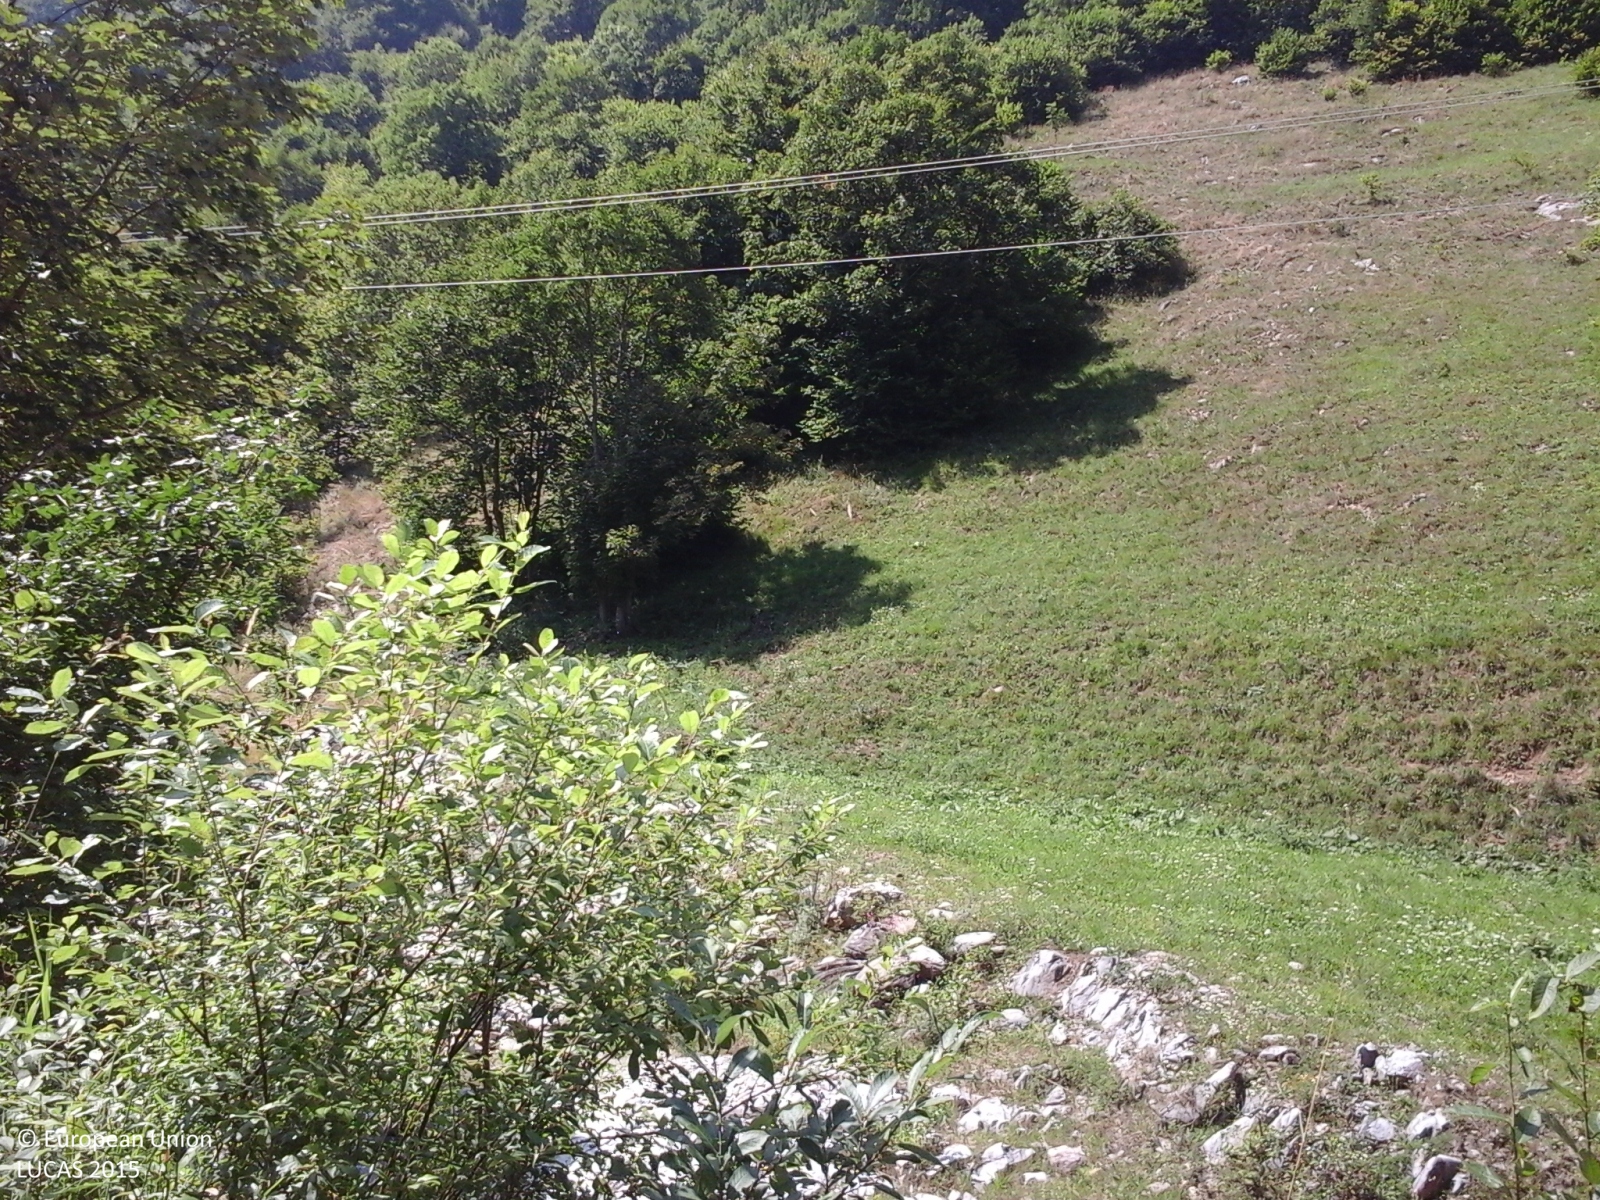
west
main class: Grassland
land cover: Grassland with sparse tree/shrub cover
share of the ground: > 75 %
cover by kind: herbaceous plants 95 %, broadleaved forest trees 5 %
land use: Agriculture (excluding fallow land and kitchen gardens)
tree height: > 5 m
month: August
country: IT
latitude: 44.2543
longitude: 7.7631
